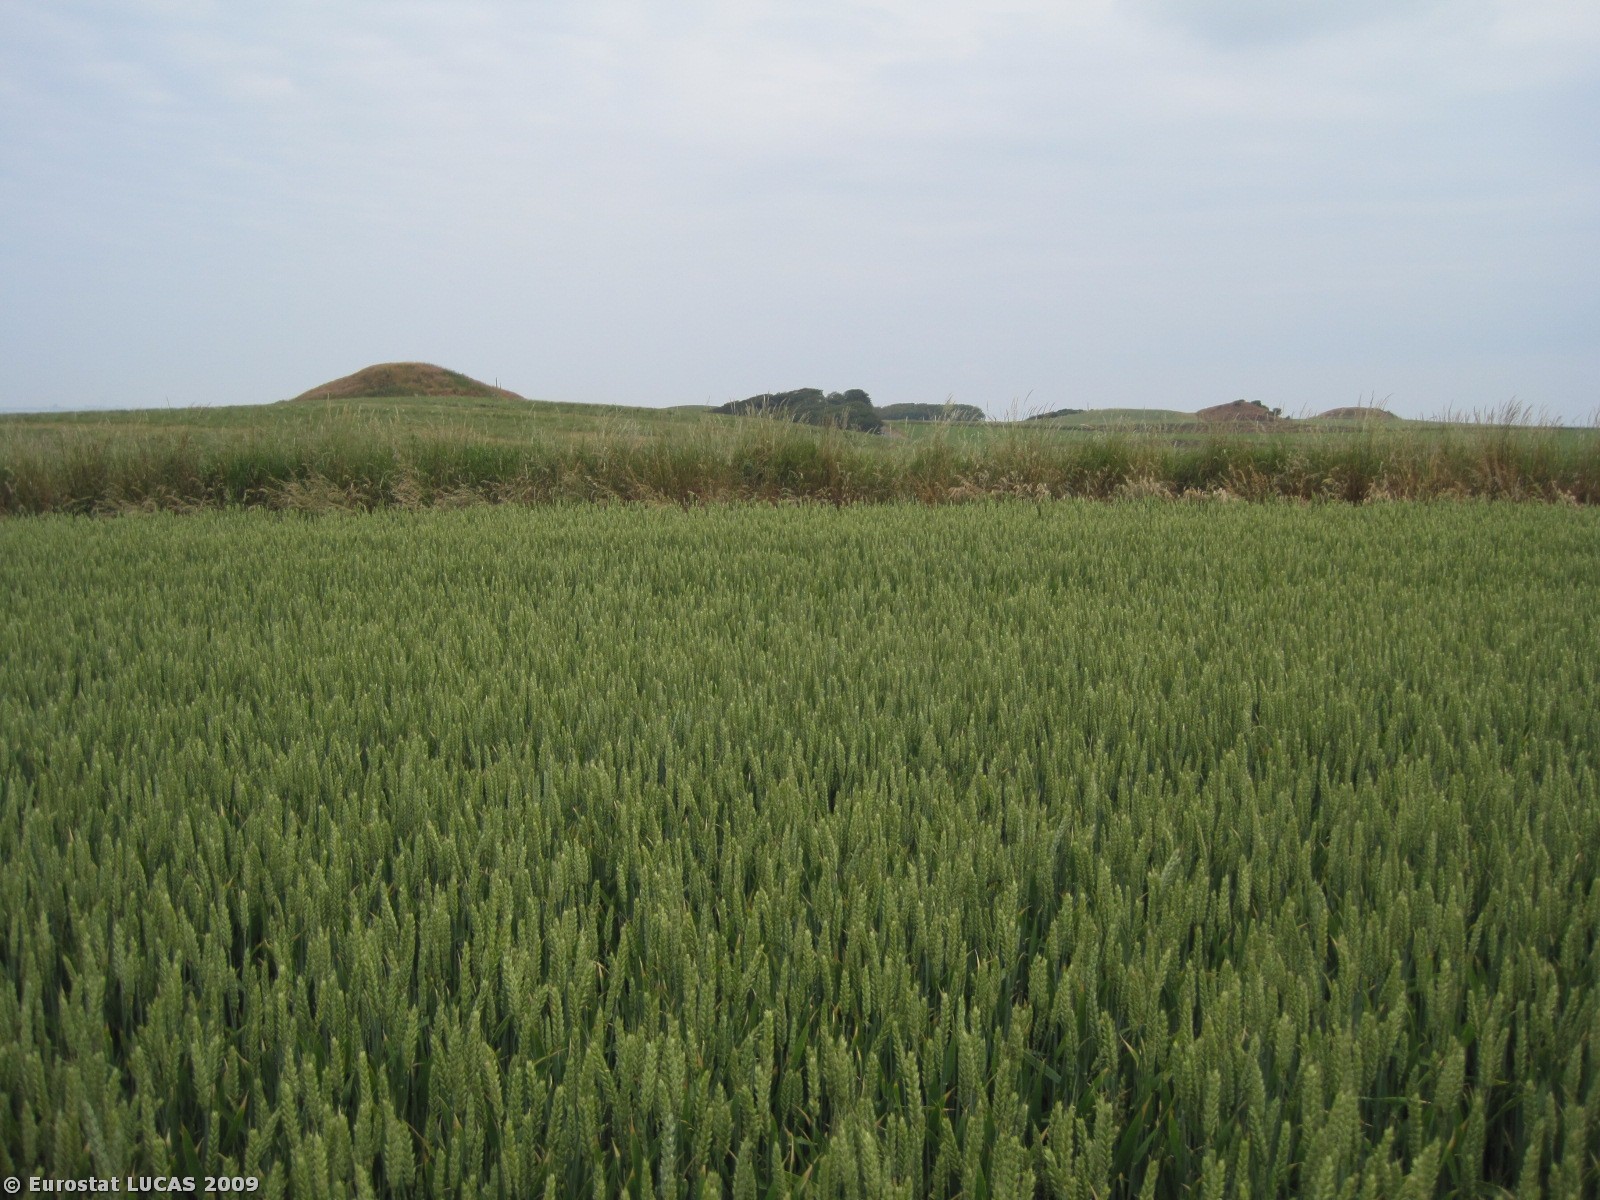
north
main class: Cropland
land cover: Common wheat
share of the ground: > 75 %
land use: Agriculture (excluding fallow land and kitchen gardens)
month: June
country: DK
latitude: 56.5716
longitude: 8.2606
